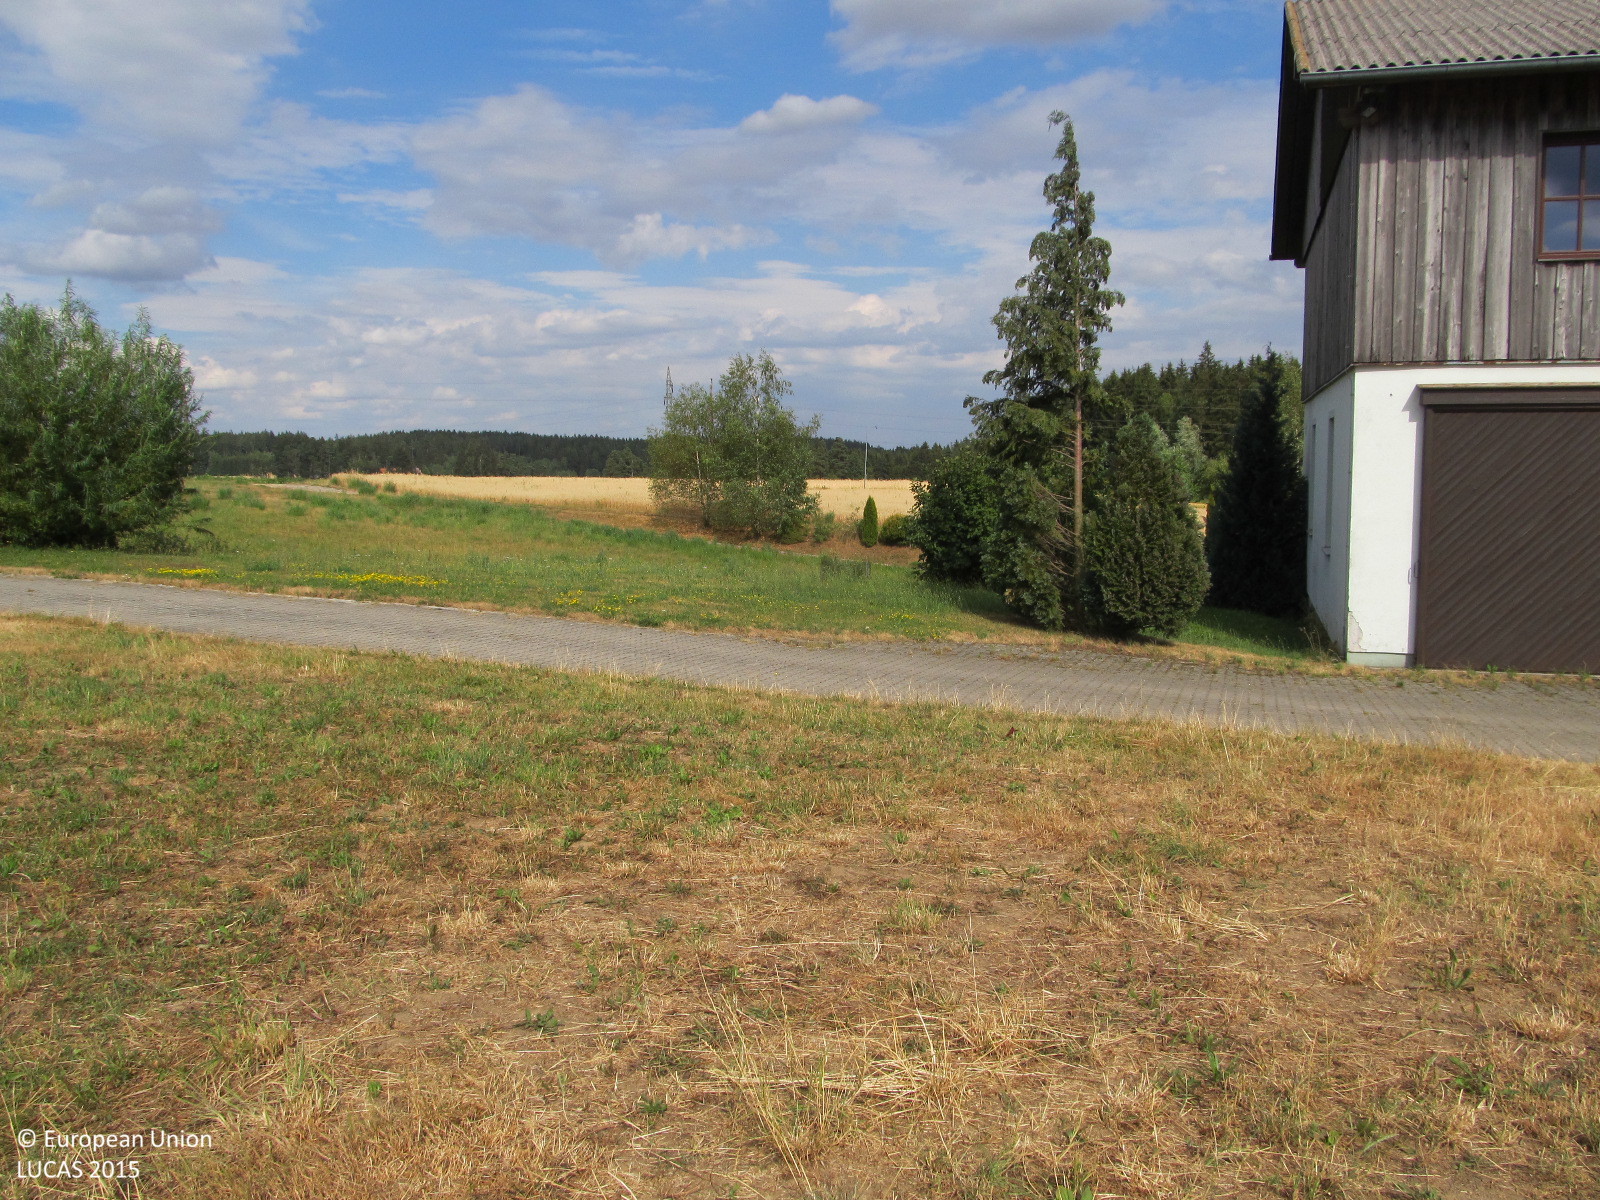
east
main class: Grassland
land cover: Grassland without tree/shrub cover
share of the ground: > 75 %
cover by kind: herbaceous plants 95 %, consolidated bare surface 5 %
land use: Agriculture (excluding fallow land and kitchen gardens)
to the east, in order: Grassland without tree/shrub cover; Artificial constructions in urban areas; Grass margins; Oats; Electric lines; Oats; Grassland without tree/shrub cover; Paved roads, cycling and walking lanes; Grassland without tree/shrub cover; Tracks; Potatoes; Dry pulses; Grass margins; Potatoes; Grass margins; Common wheat; Grass margins; Electric lines; Potatoes; Grass margins; Potatoes
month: July
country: AT
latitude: 48.6839
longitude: 15.0684
